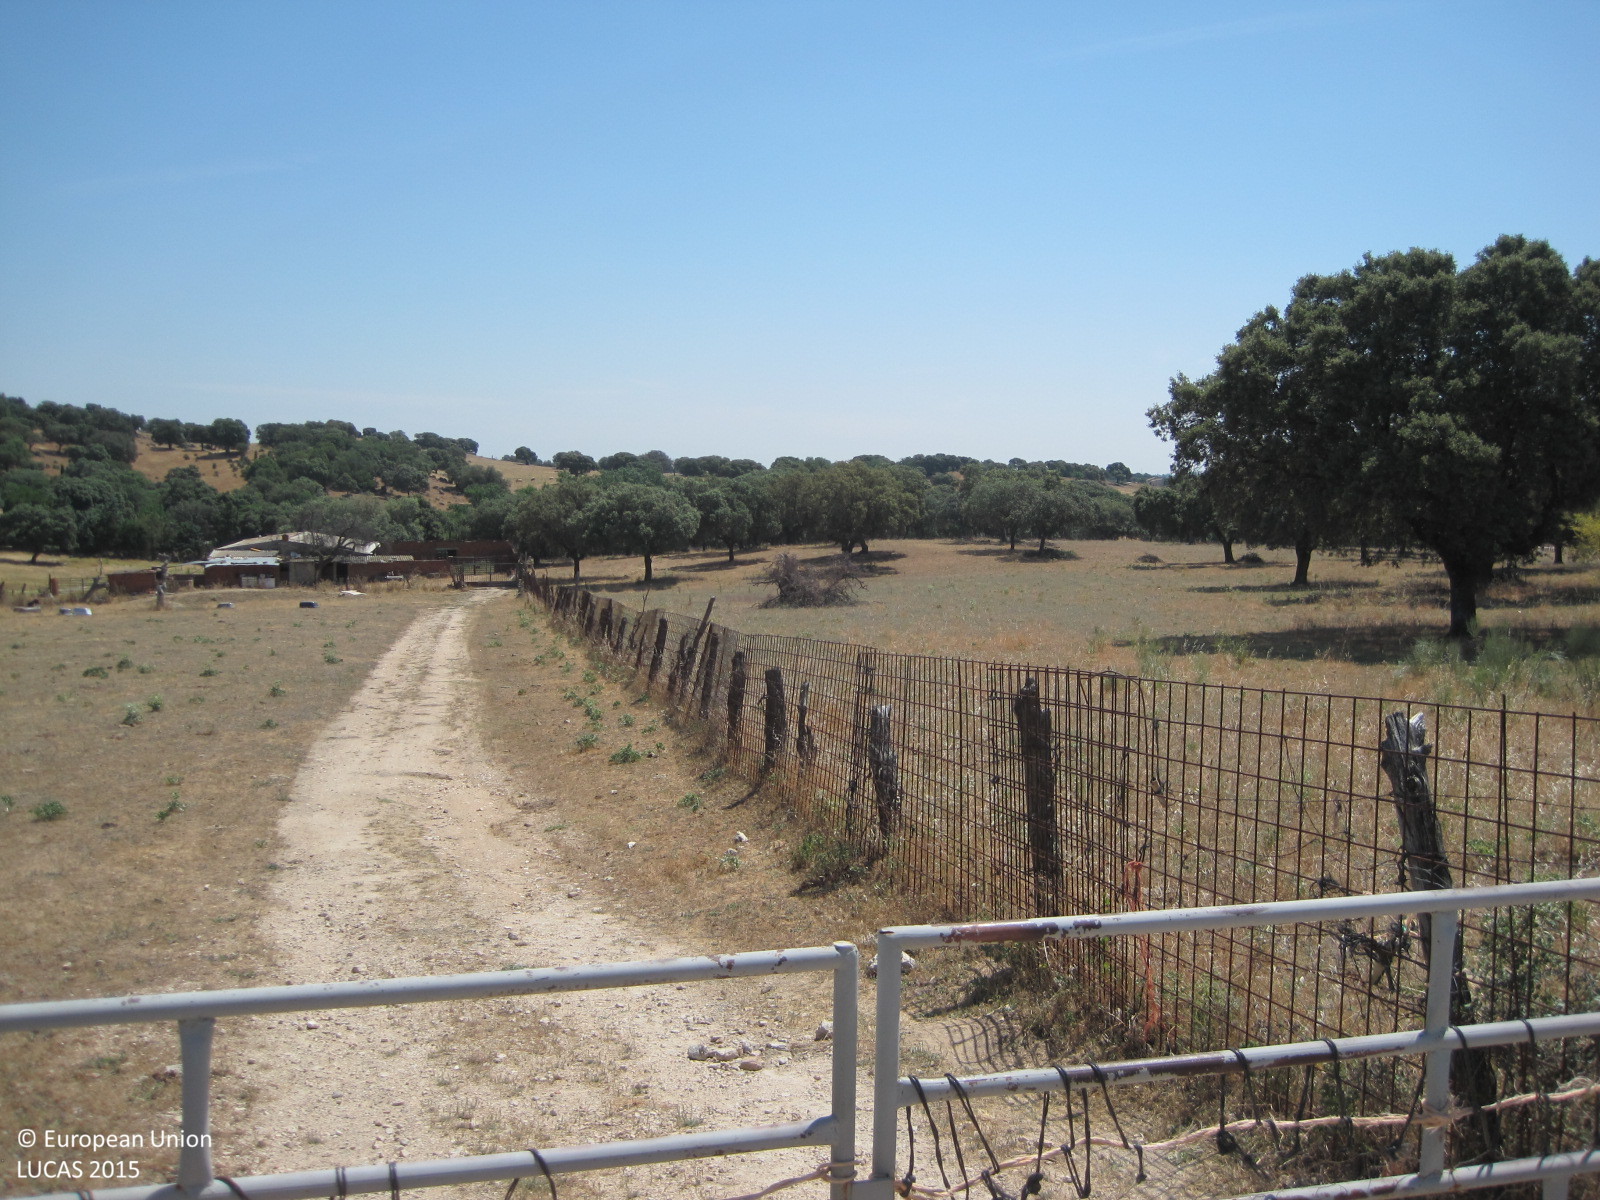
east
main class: Woodland
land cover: Broadleaved woodland
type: broadleaved evergreen forest
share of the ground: 50 - 75 %
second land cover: Grassland without tree/shrub cover
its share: > 75 %
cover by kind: broadleaved forest trees 45 %, herbaceous plants 45 %, unconsolidated bare surface 10 %
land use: Forestry
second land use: Agriculture (excluding fallow land and kitchen gardens)
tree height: < 5 m
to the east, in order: Broadleaved woodland; Grassland without tree/shrub cover; Tracks; Grassland with sparse tree/shrub cover; Broadleaved woodland; Grassland without tree/shrub cover
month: June
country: ES
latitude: 40.0404
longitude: -4.7804
